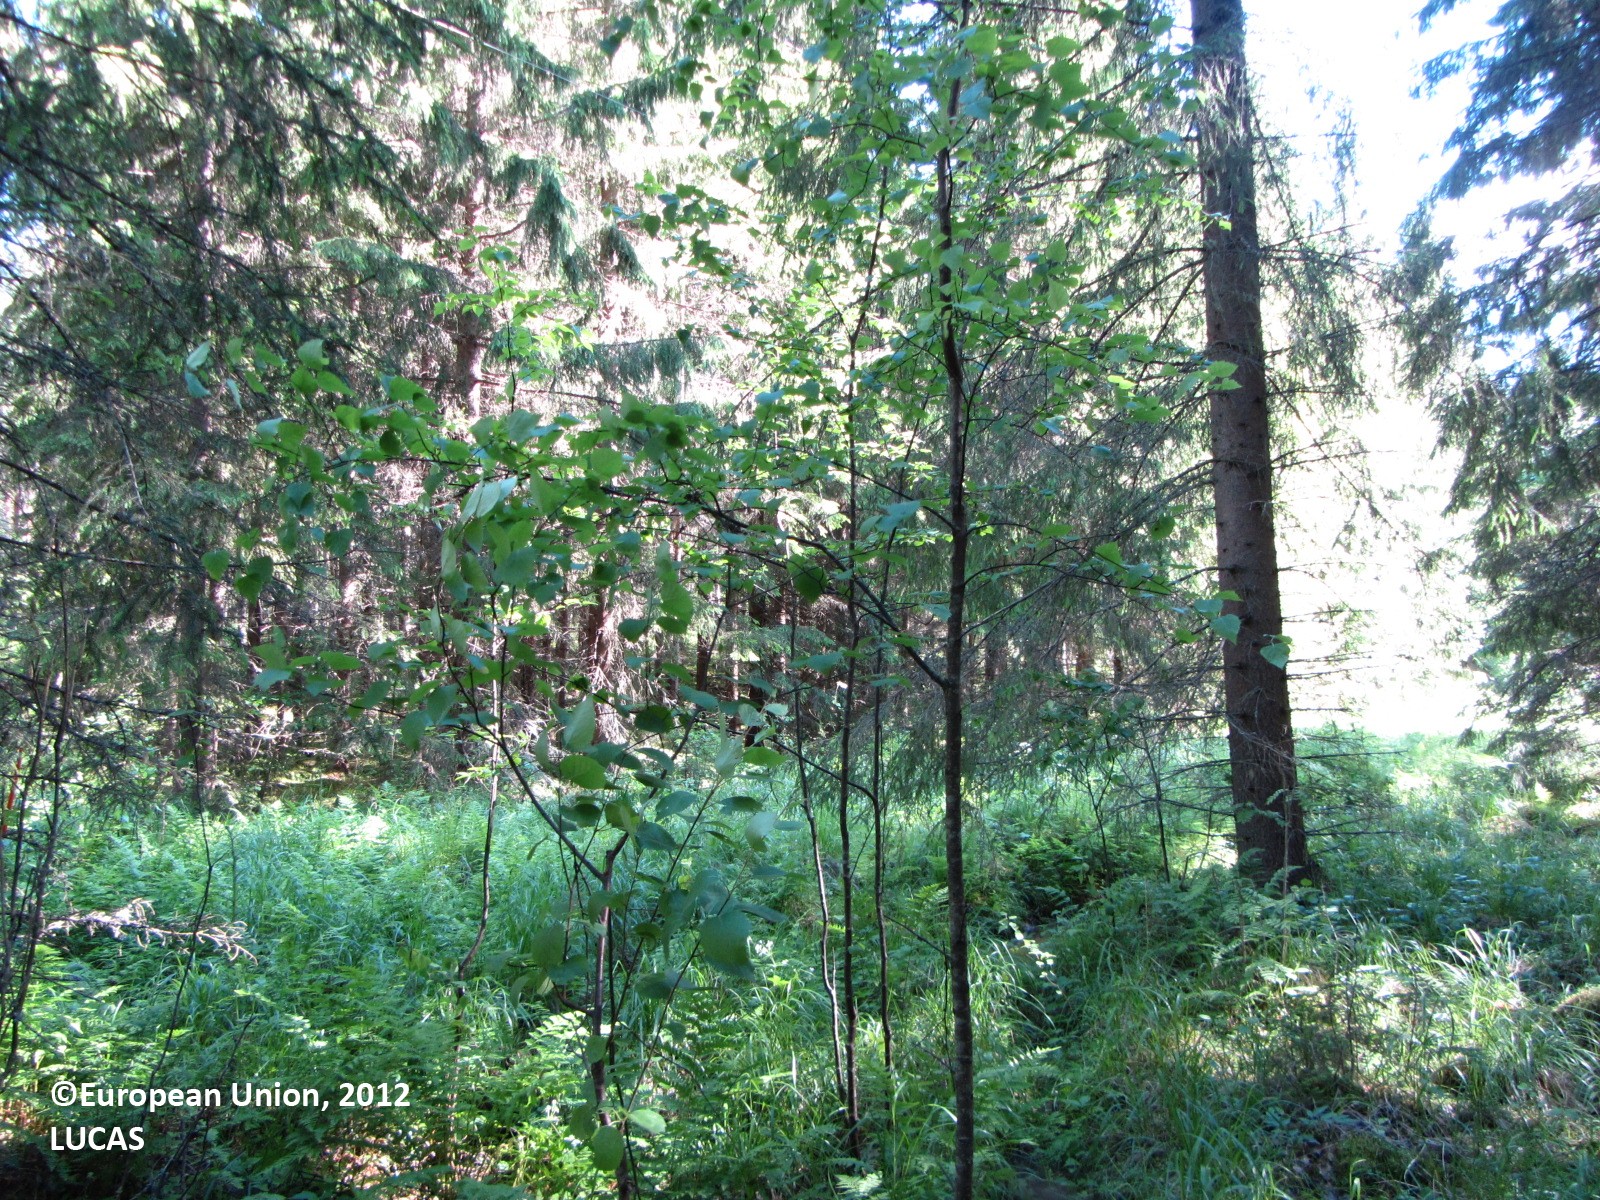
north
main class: Woodland
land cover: Spruce dominated mixed woodland
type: boreal forest
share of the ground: 50 - 75 %
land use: Forestry
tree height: > 5 m
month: June
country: FI
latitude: 62.0174
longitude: 25.7306
